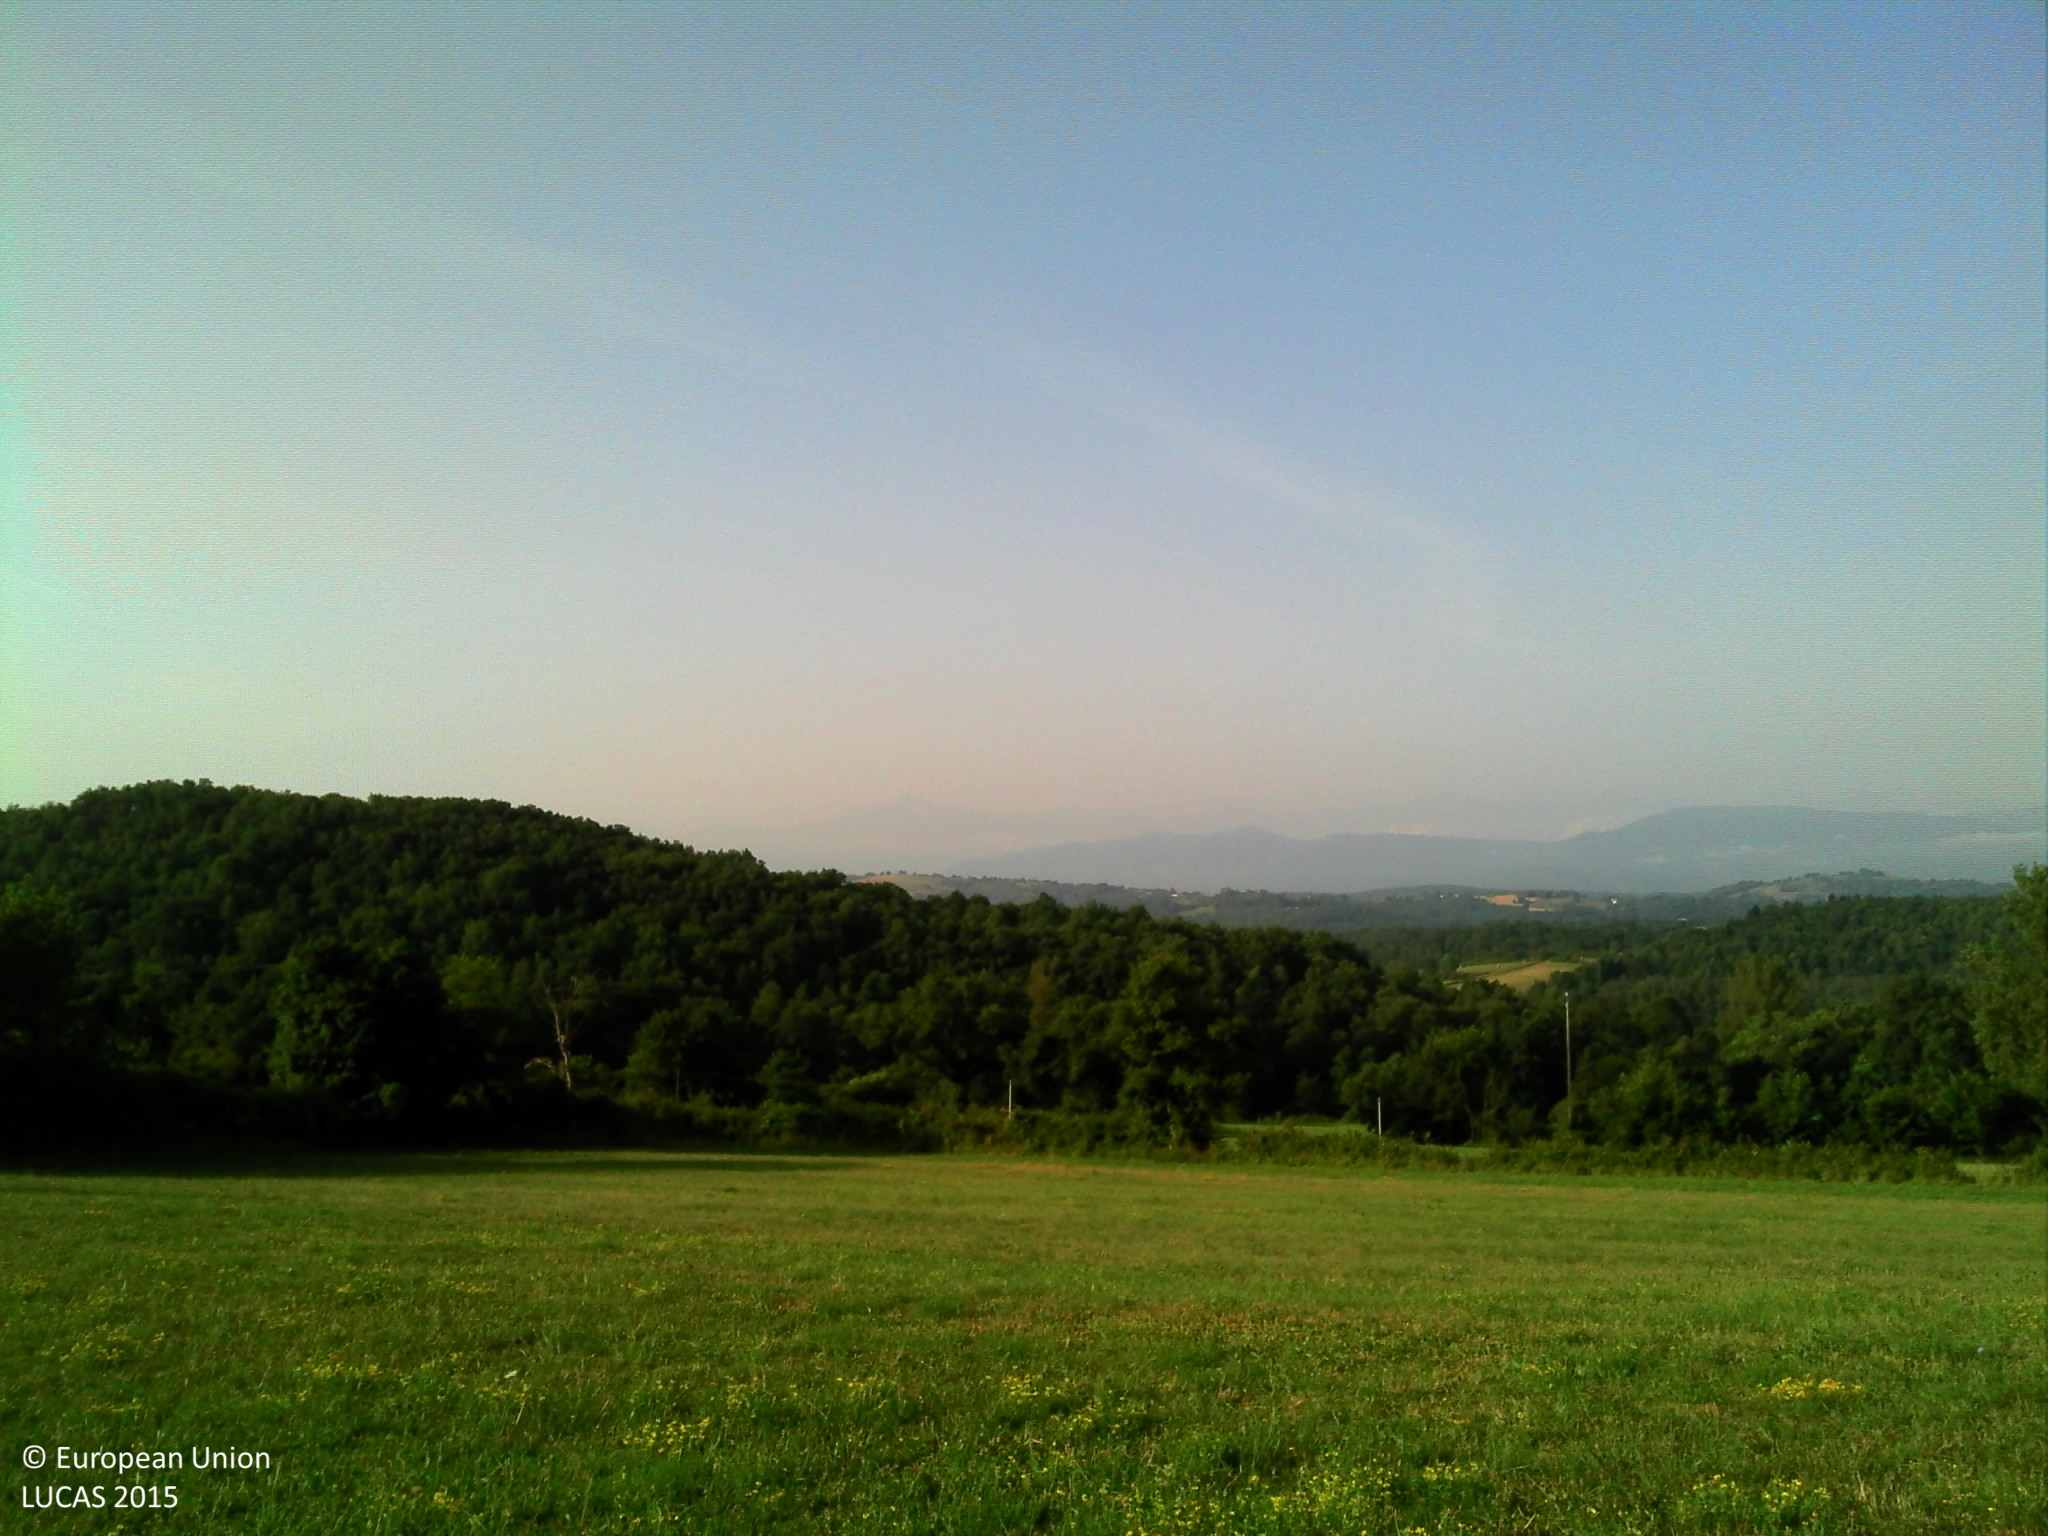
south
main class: Grassland
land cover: Grassland without tree/shrub cover
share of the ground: > 75 %
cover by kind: herbaceous plants 100 %
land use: Agriculture (excluding fallow land and kitchen gardens)
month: July
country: FR
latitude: 43.1300
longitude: 1.0667
